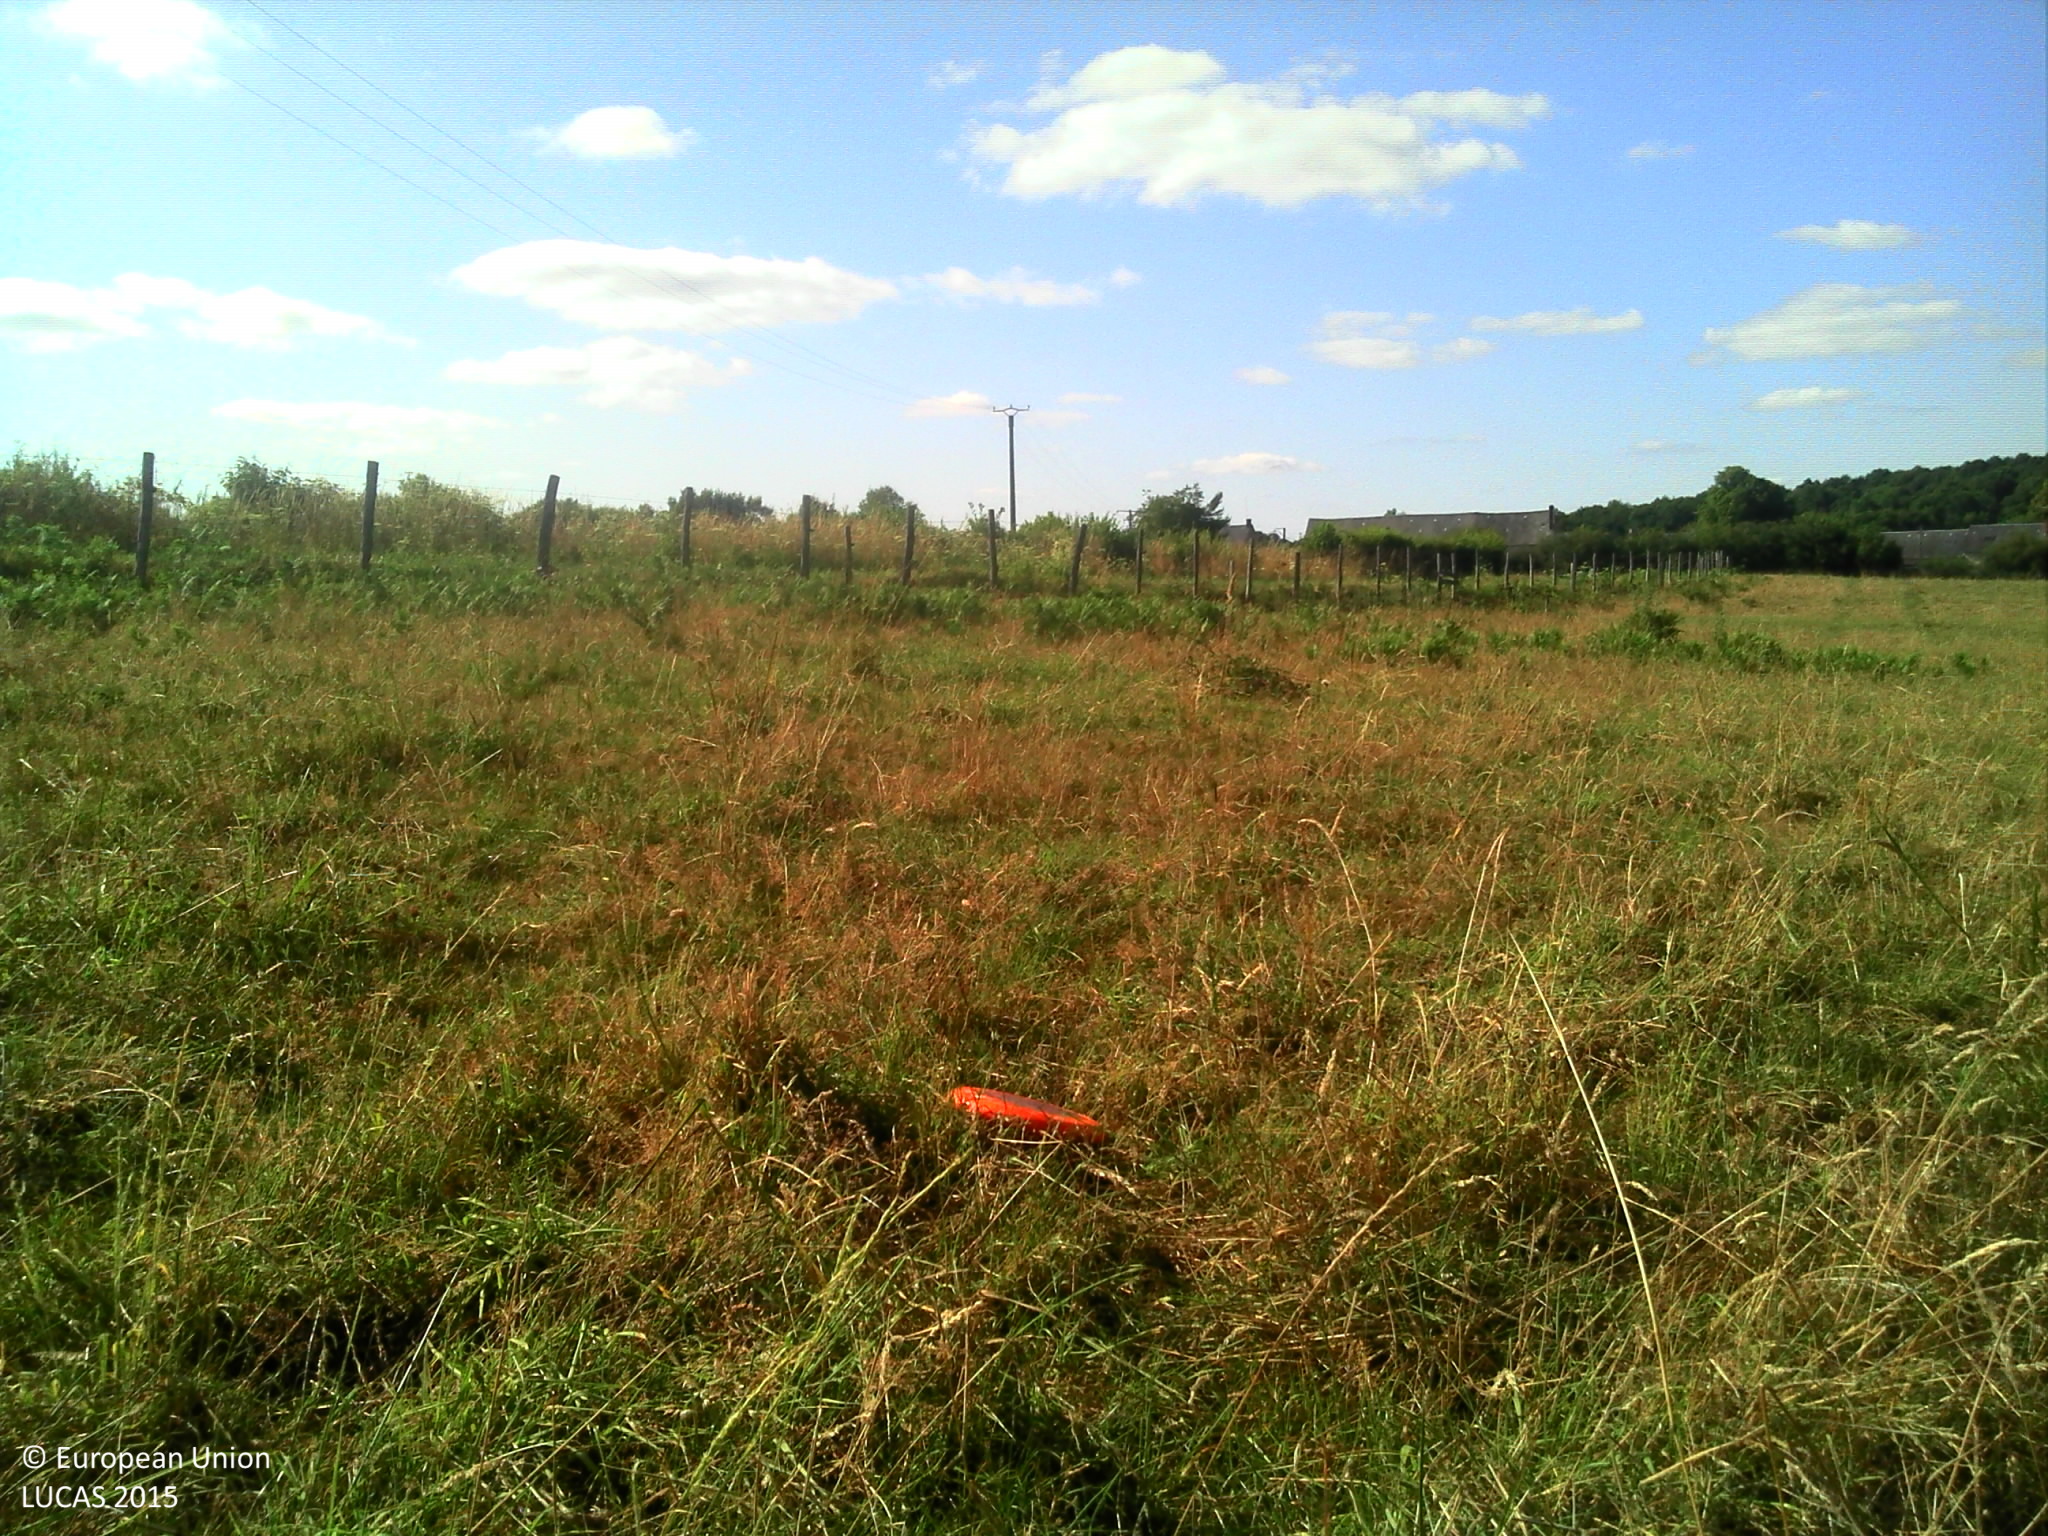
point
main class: Grassland
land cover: Grassland without tree/shrub cover
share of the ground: > 75 %
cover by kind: herbaceous plants 100 %
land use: Agriculture (excluding fallow land and kitchen gardens)
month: July
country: FR
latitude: 46.3072
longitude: 1.5639
